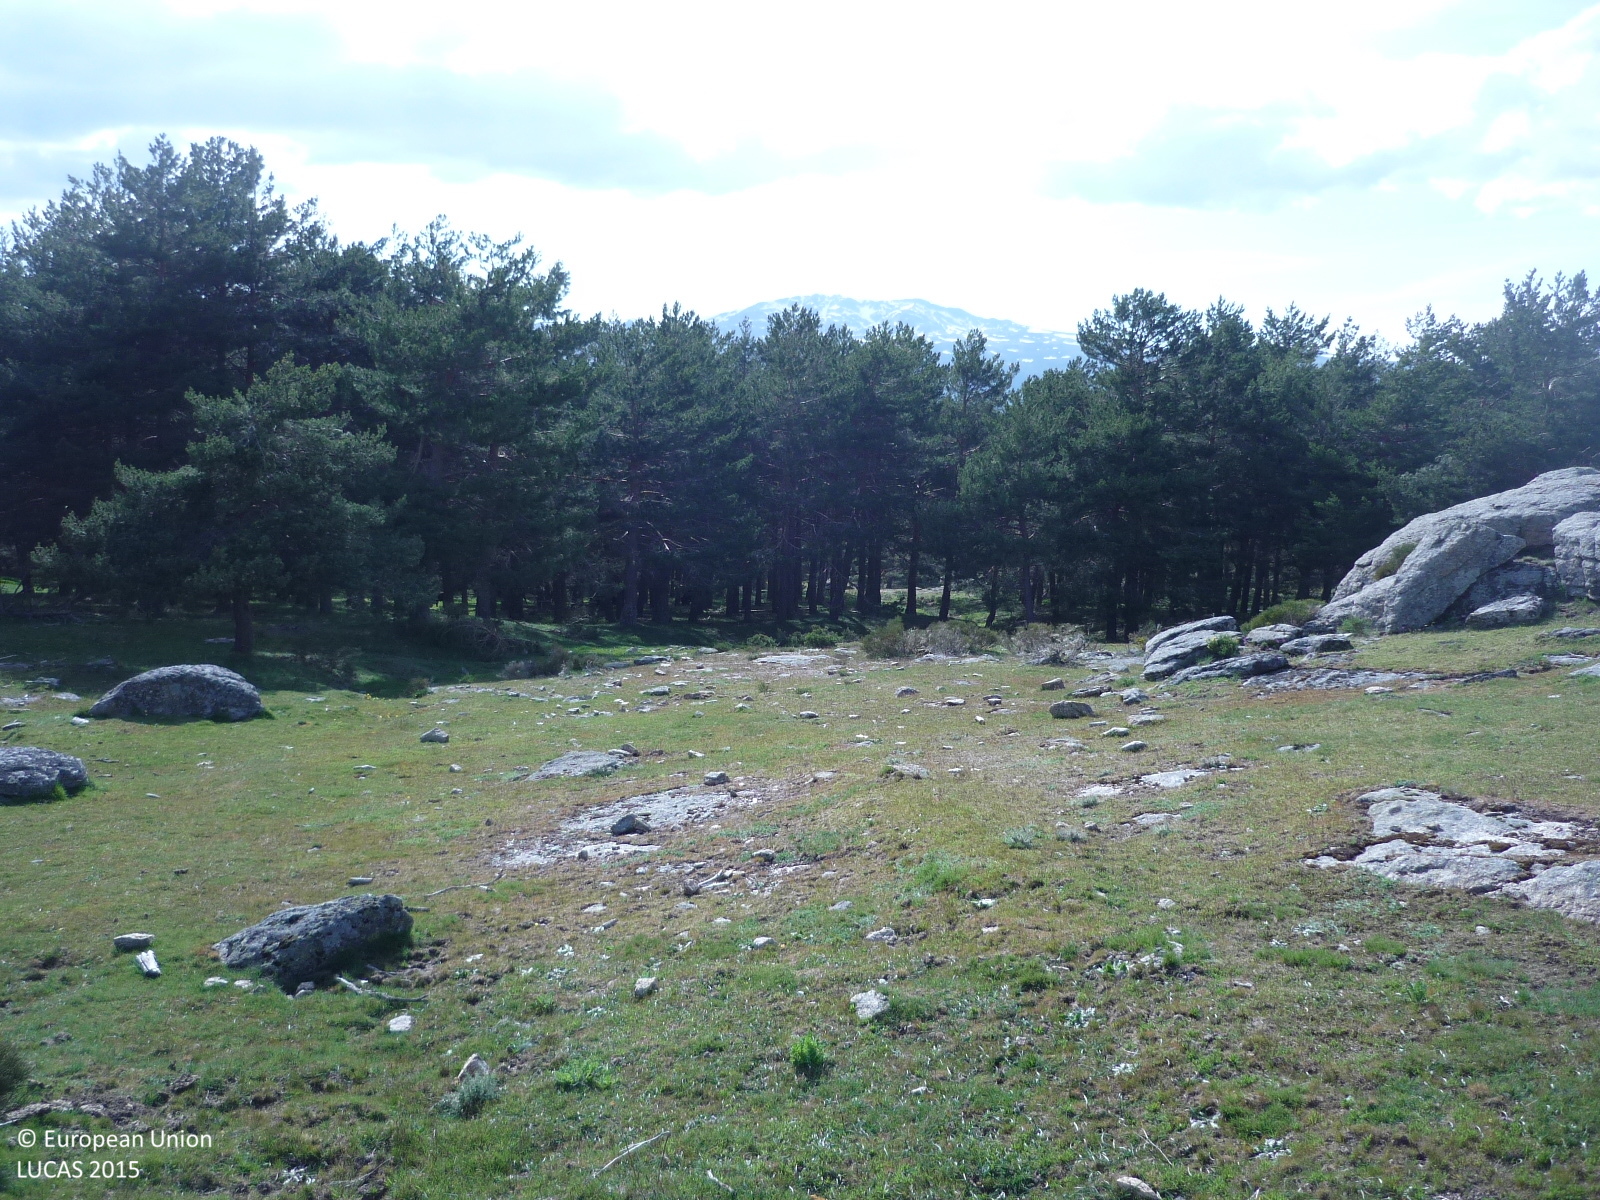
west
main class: Grassland
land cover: Grassland with sparse tree/shrub cover
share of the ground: > 75 %
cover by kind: herbaceous plants 85 %, shrubs 10 %, coniferous forest trees 5 %
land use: Agriculture (excluding fallow land and kitchen gardens)
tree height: < 5 m
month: May
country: ES
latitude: 40.8388
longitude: -3.8375
